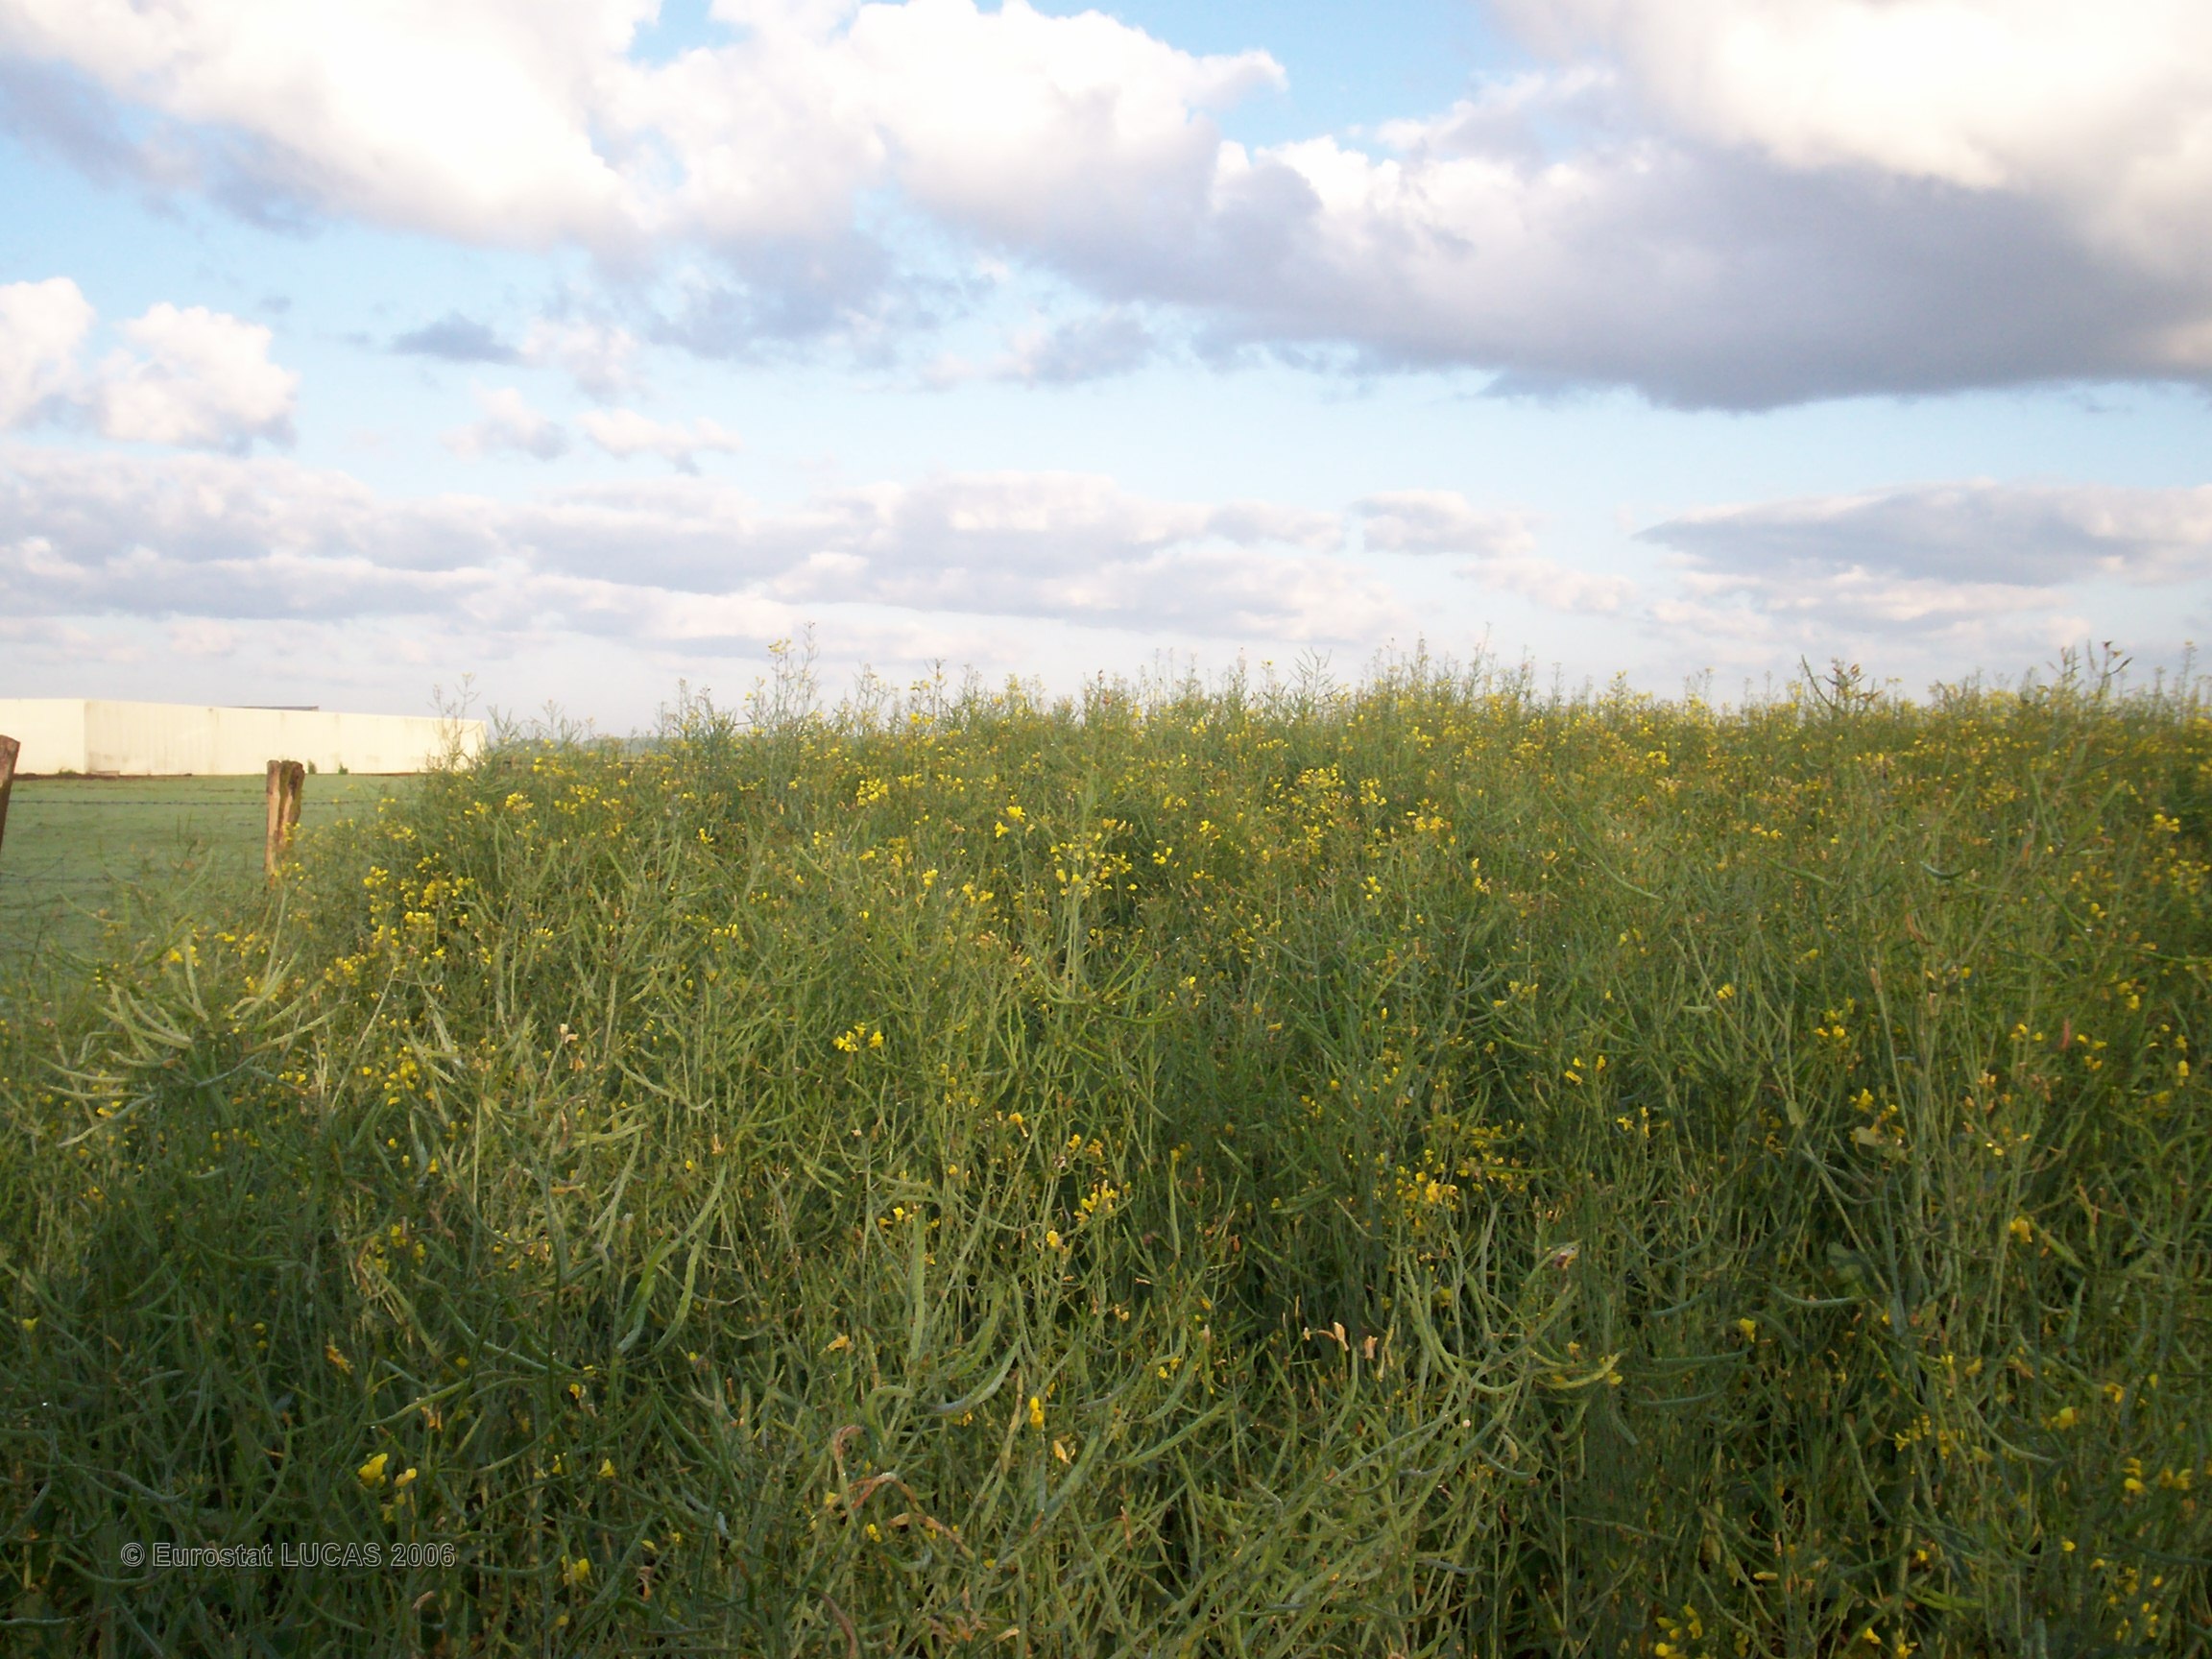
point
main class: Cropland
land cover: Rape and turnip rape
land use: Agriculture (excluding fallow land and kitchen gardens)
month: May
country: FR
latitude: 47.0799
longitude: 5.3521
